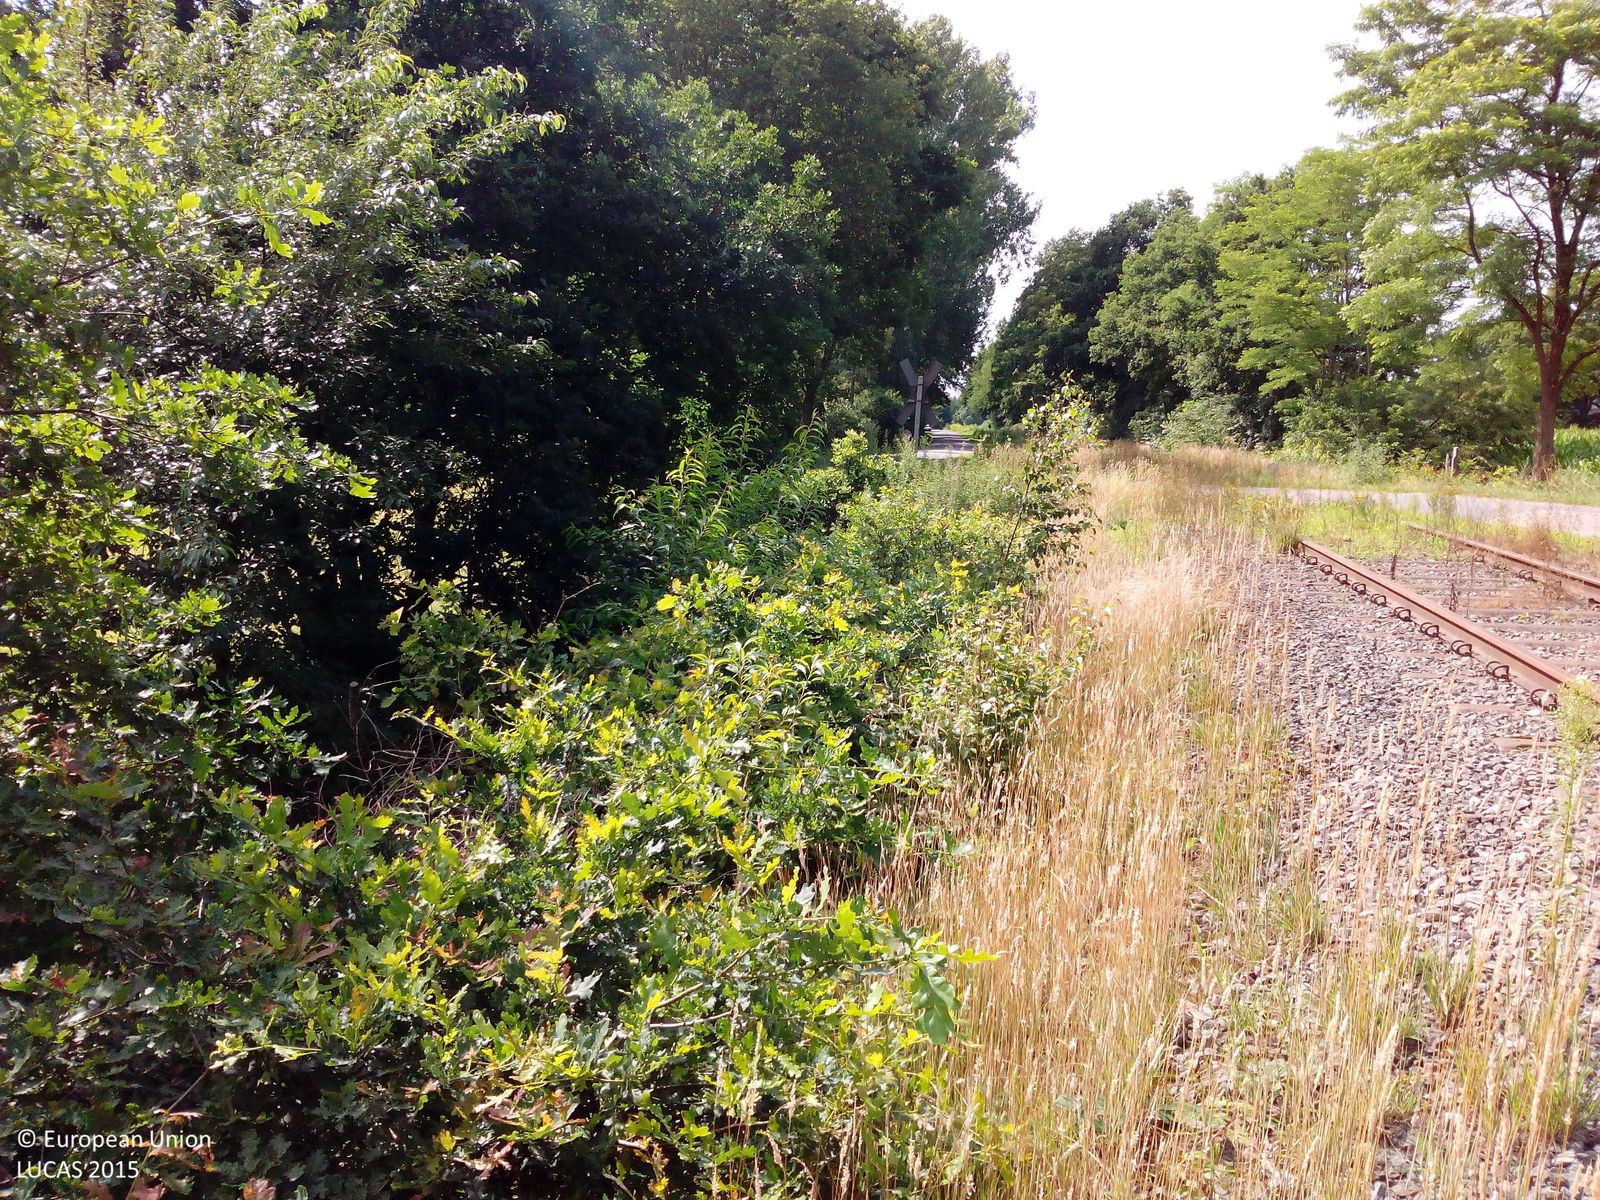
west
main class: Cropland
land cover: Maize
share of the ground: > 75 %
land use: Agriculture (excluding fallow land and kitchen gardens)
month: July
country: DE
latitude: 53.0067
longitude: 7.9291
